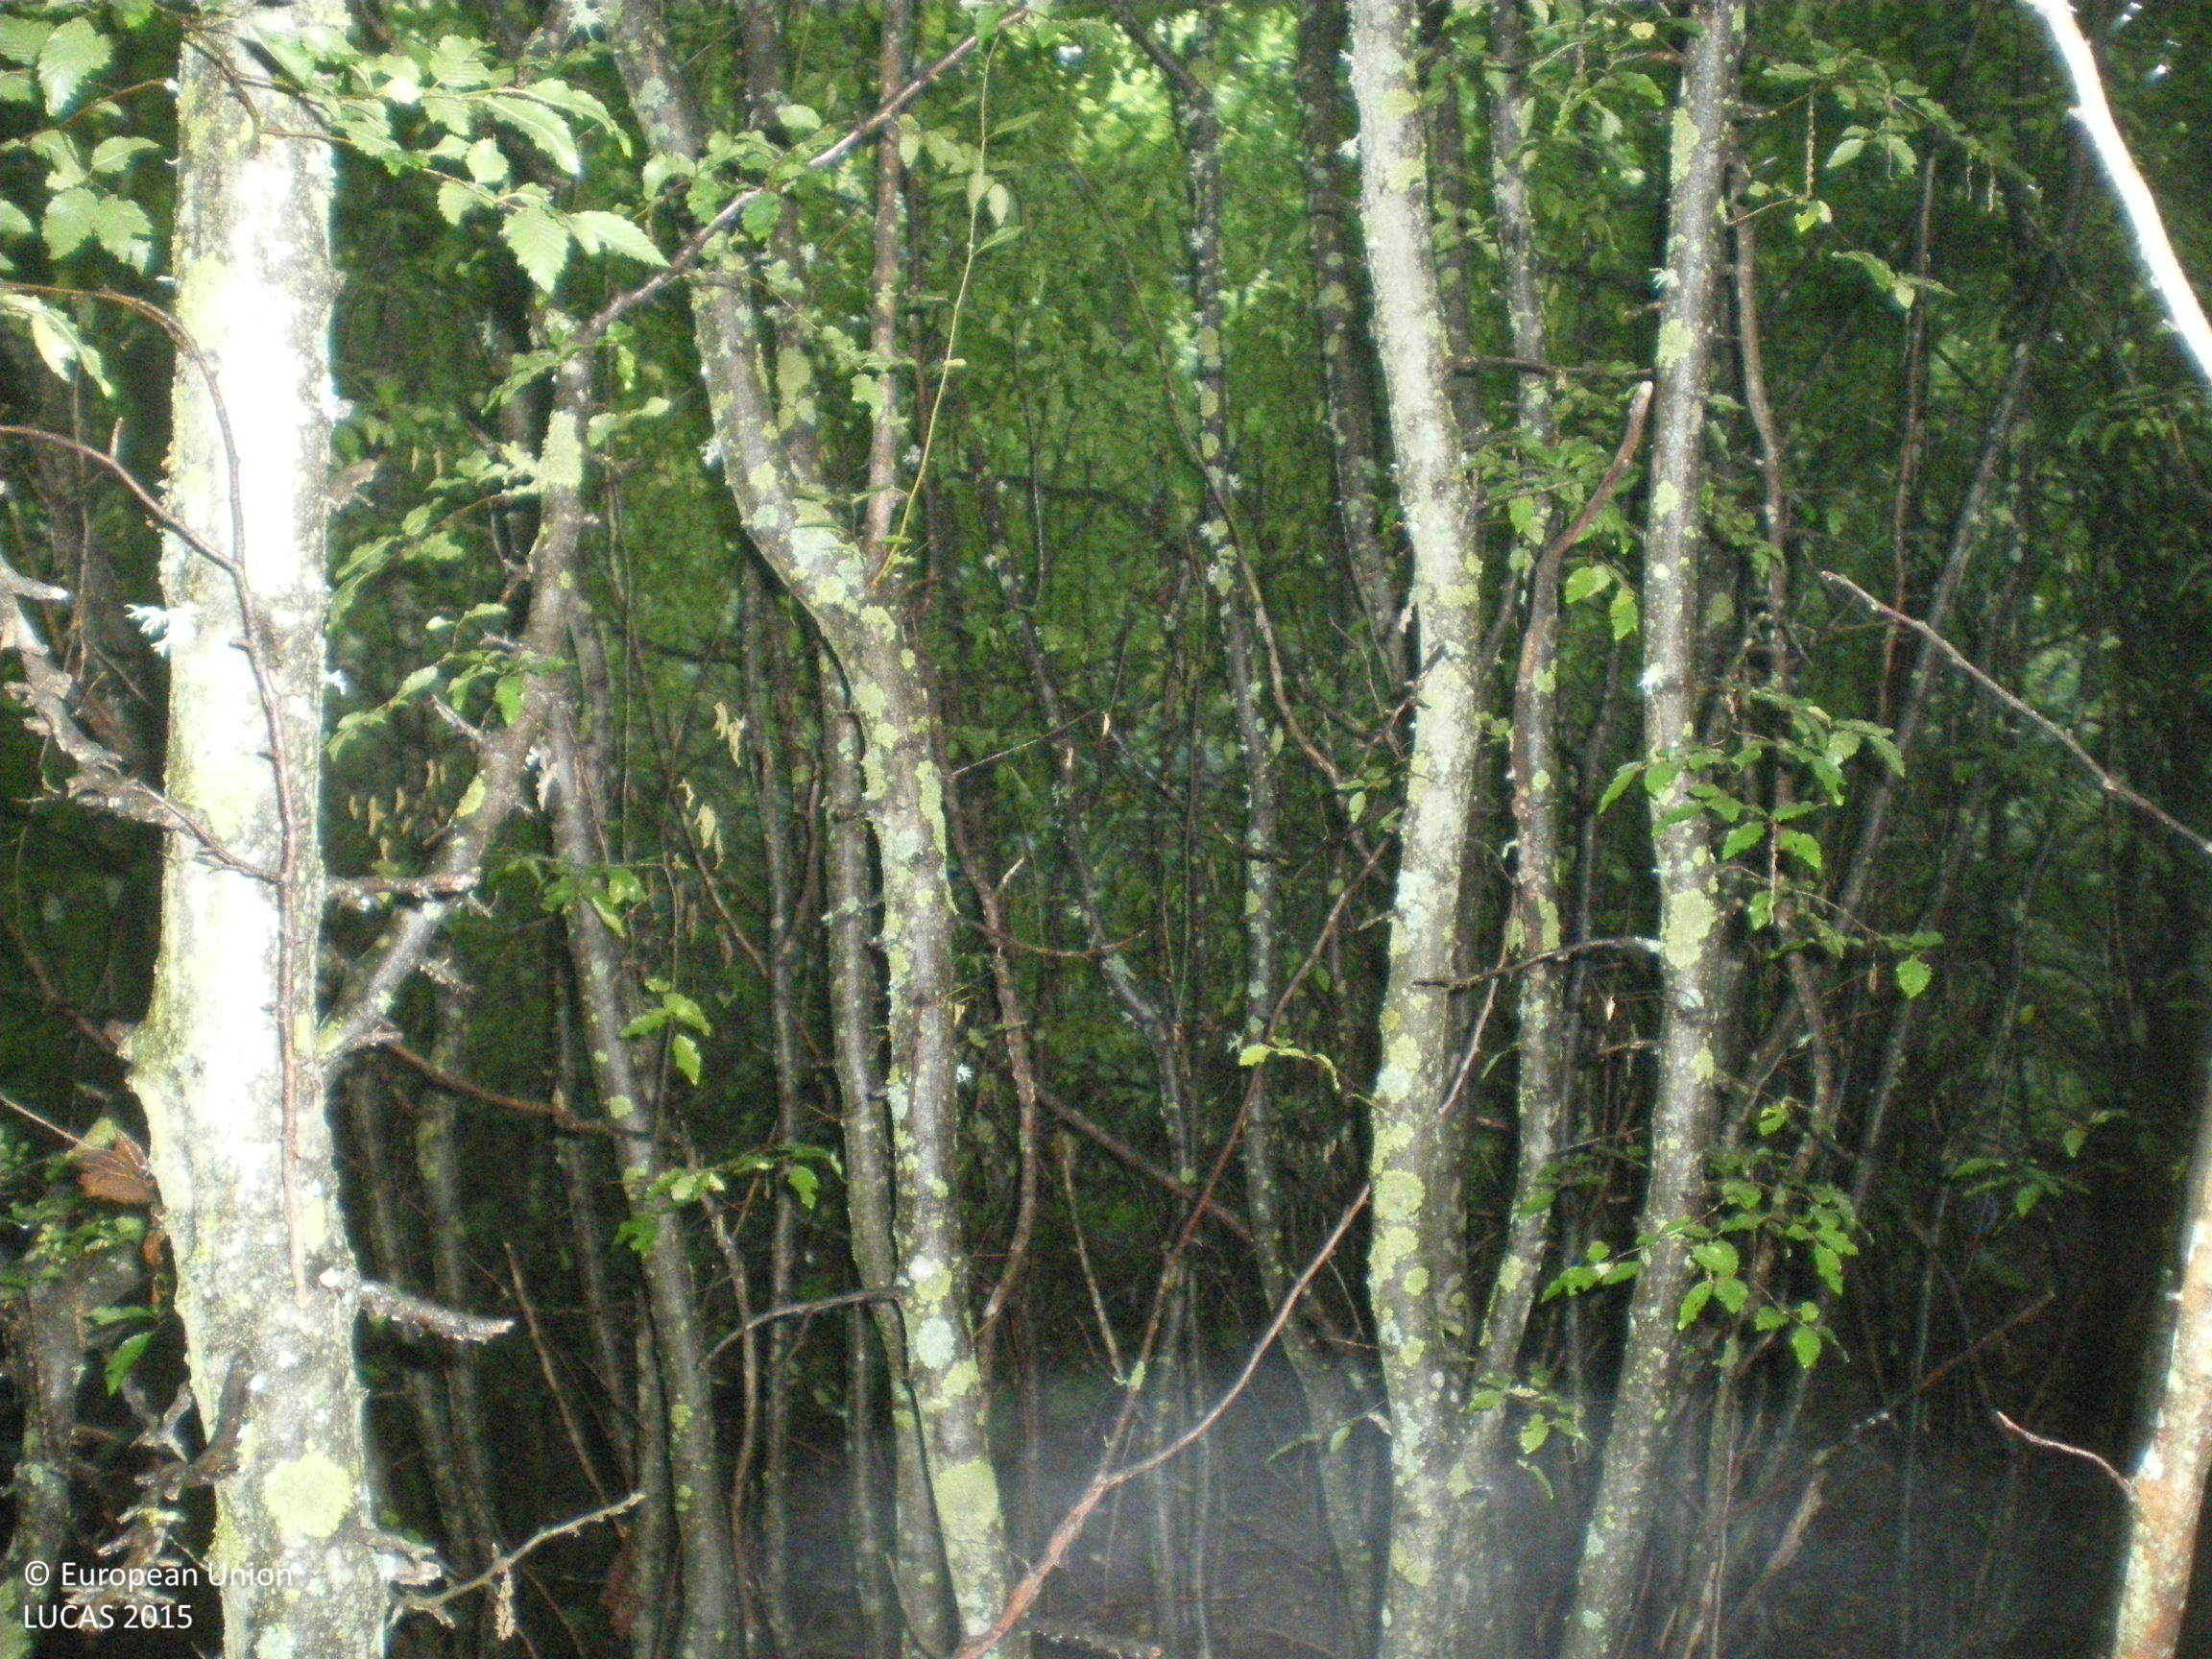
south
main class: Woodland
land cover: Broadleaved woodland
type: mesophytic deciduous forest
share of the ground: > 75 %
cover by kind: broadleaved forest trees 95 %, unconsolidated bare surface 5 %
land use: Forestry
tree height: > 5 m
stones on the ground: < 10 %
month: July
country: BG
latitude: 42.4241
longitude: 25.2690
